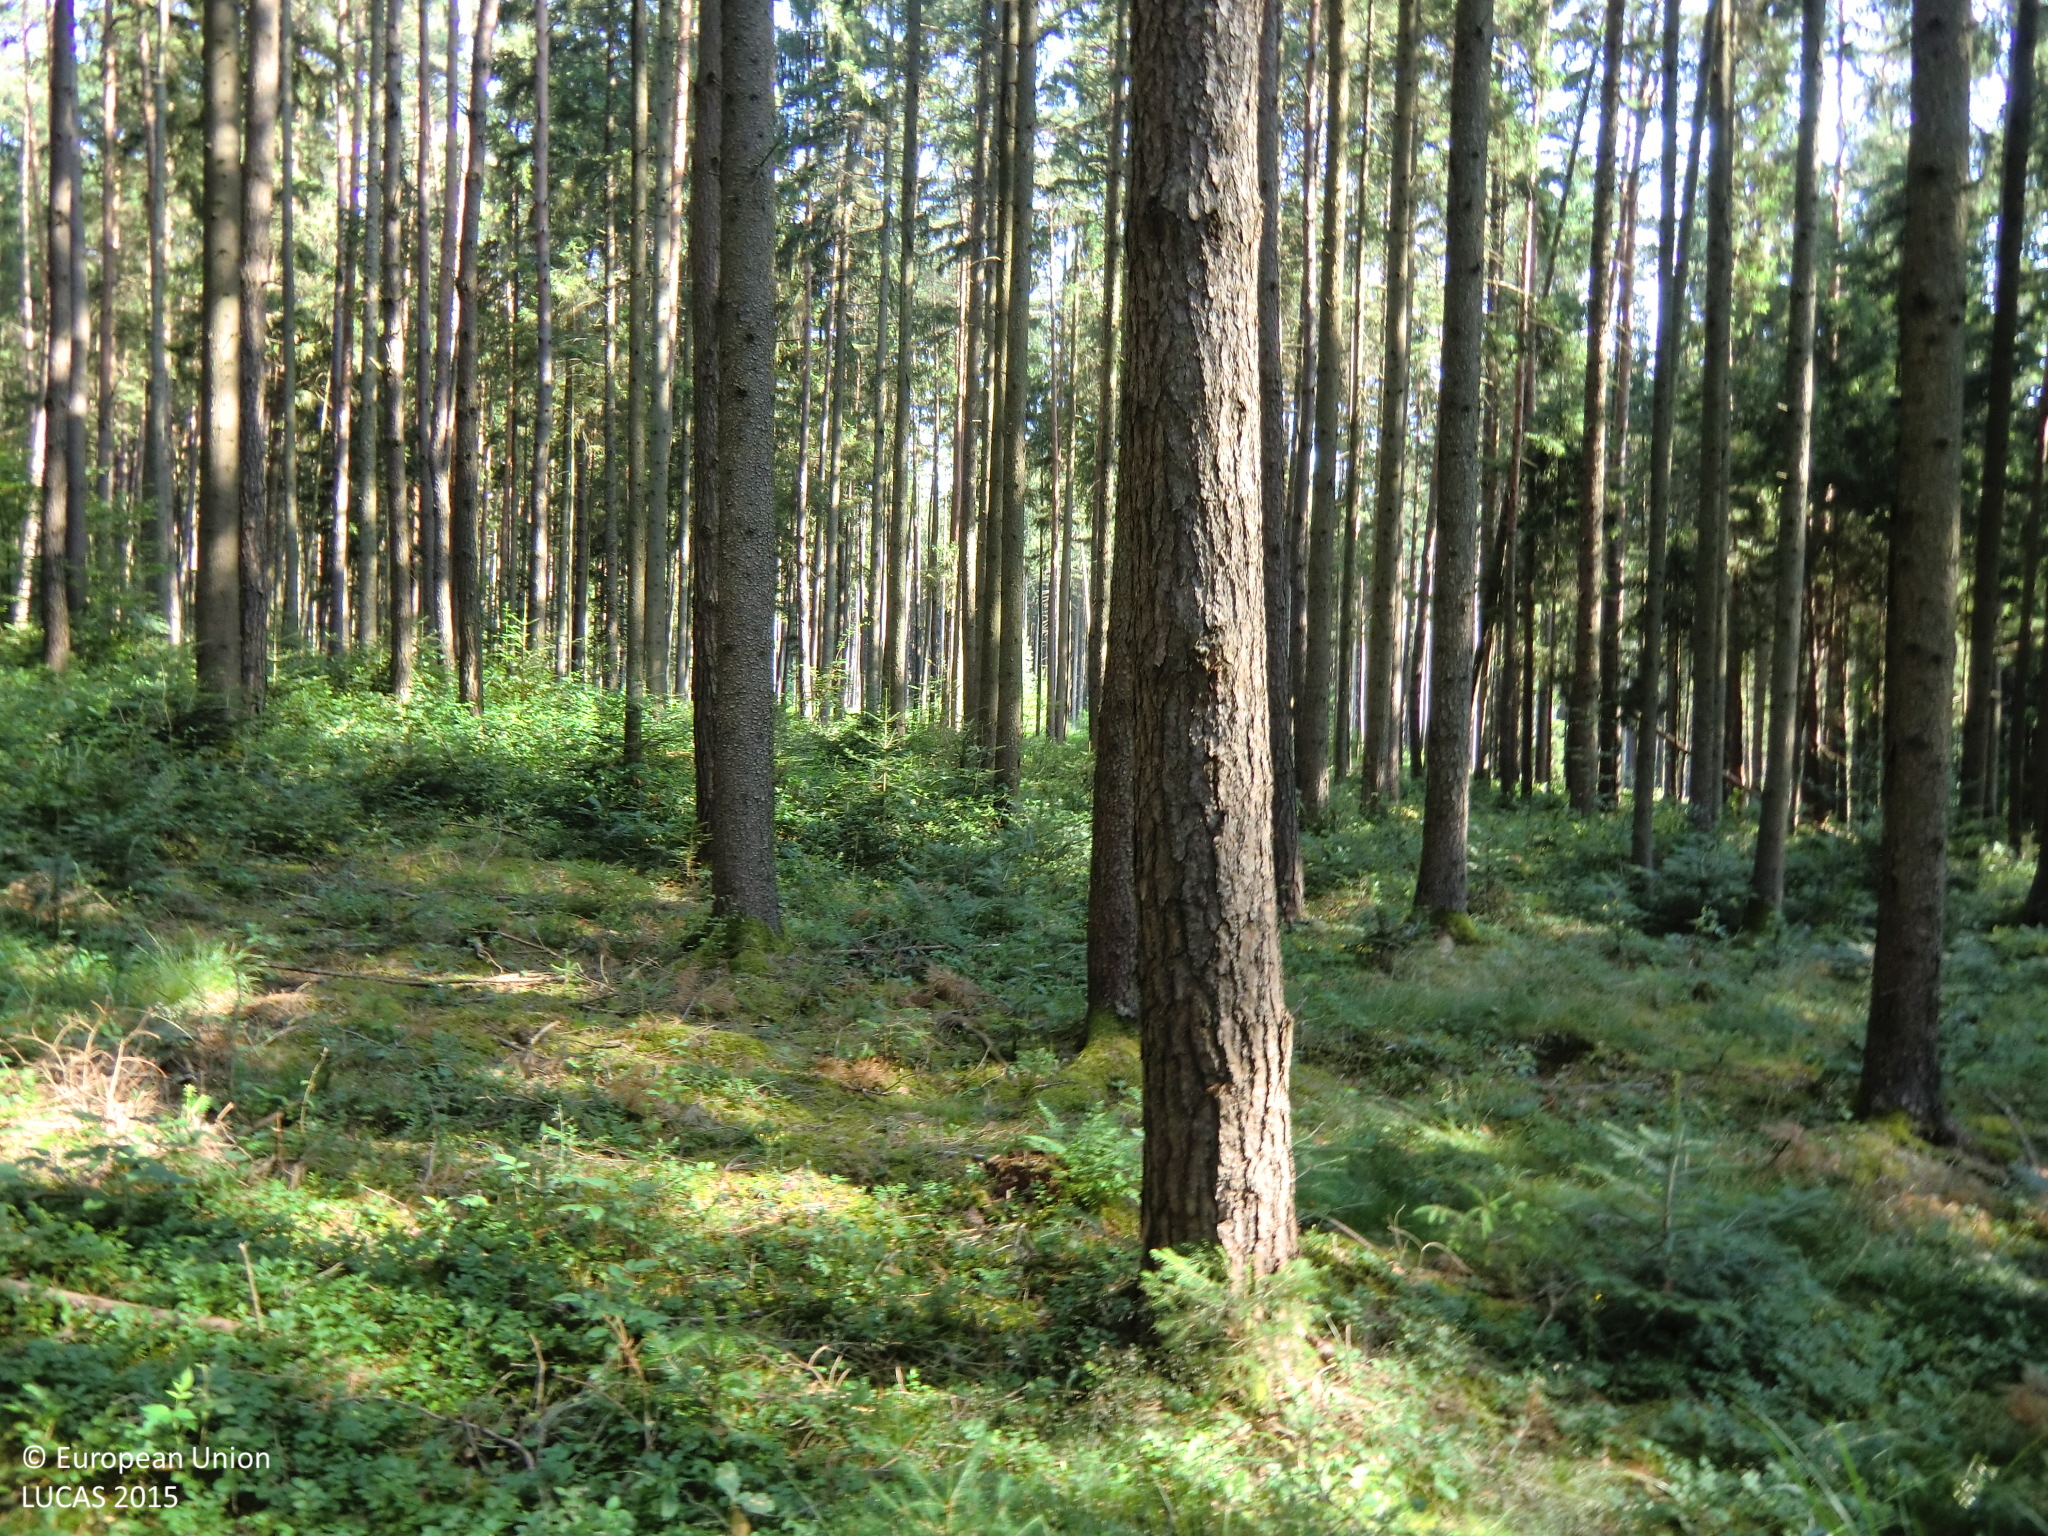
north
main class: Woodland
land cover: Spruce dominated coniferous woodland
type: hemiboreal forest and nemoral coniferous forest and mixed broadleaved-coniferous forest
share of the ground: > 75 %
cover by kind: coniferous forest trees 75 %, shrubs 15 %, herbaceous plants 10 %
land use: Forestry
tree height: > 5 m
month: July
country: AT
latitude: 47.2502
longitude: 15.9605
